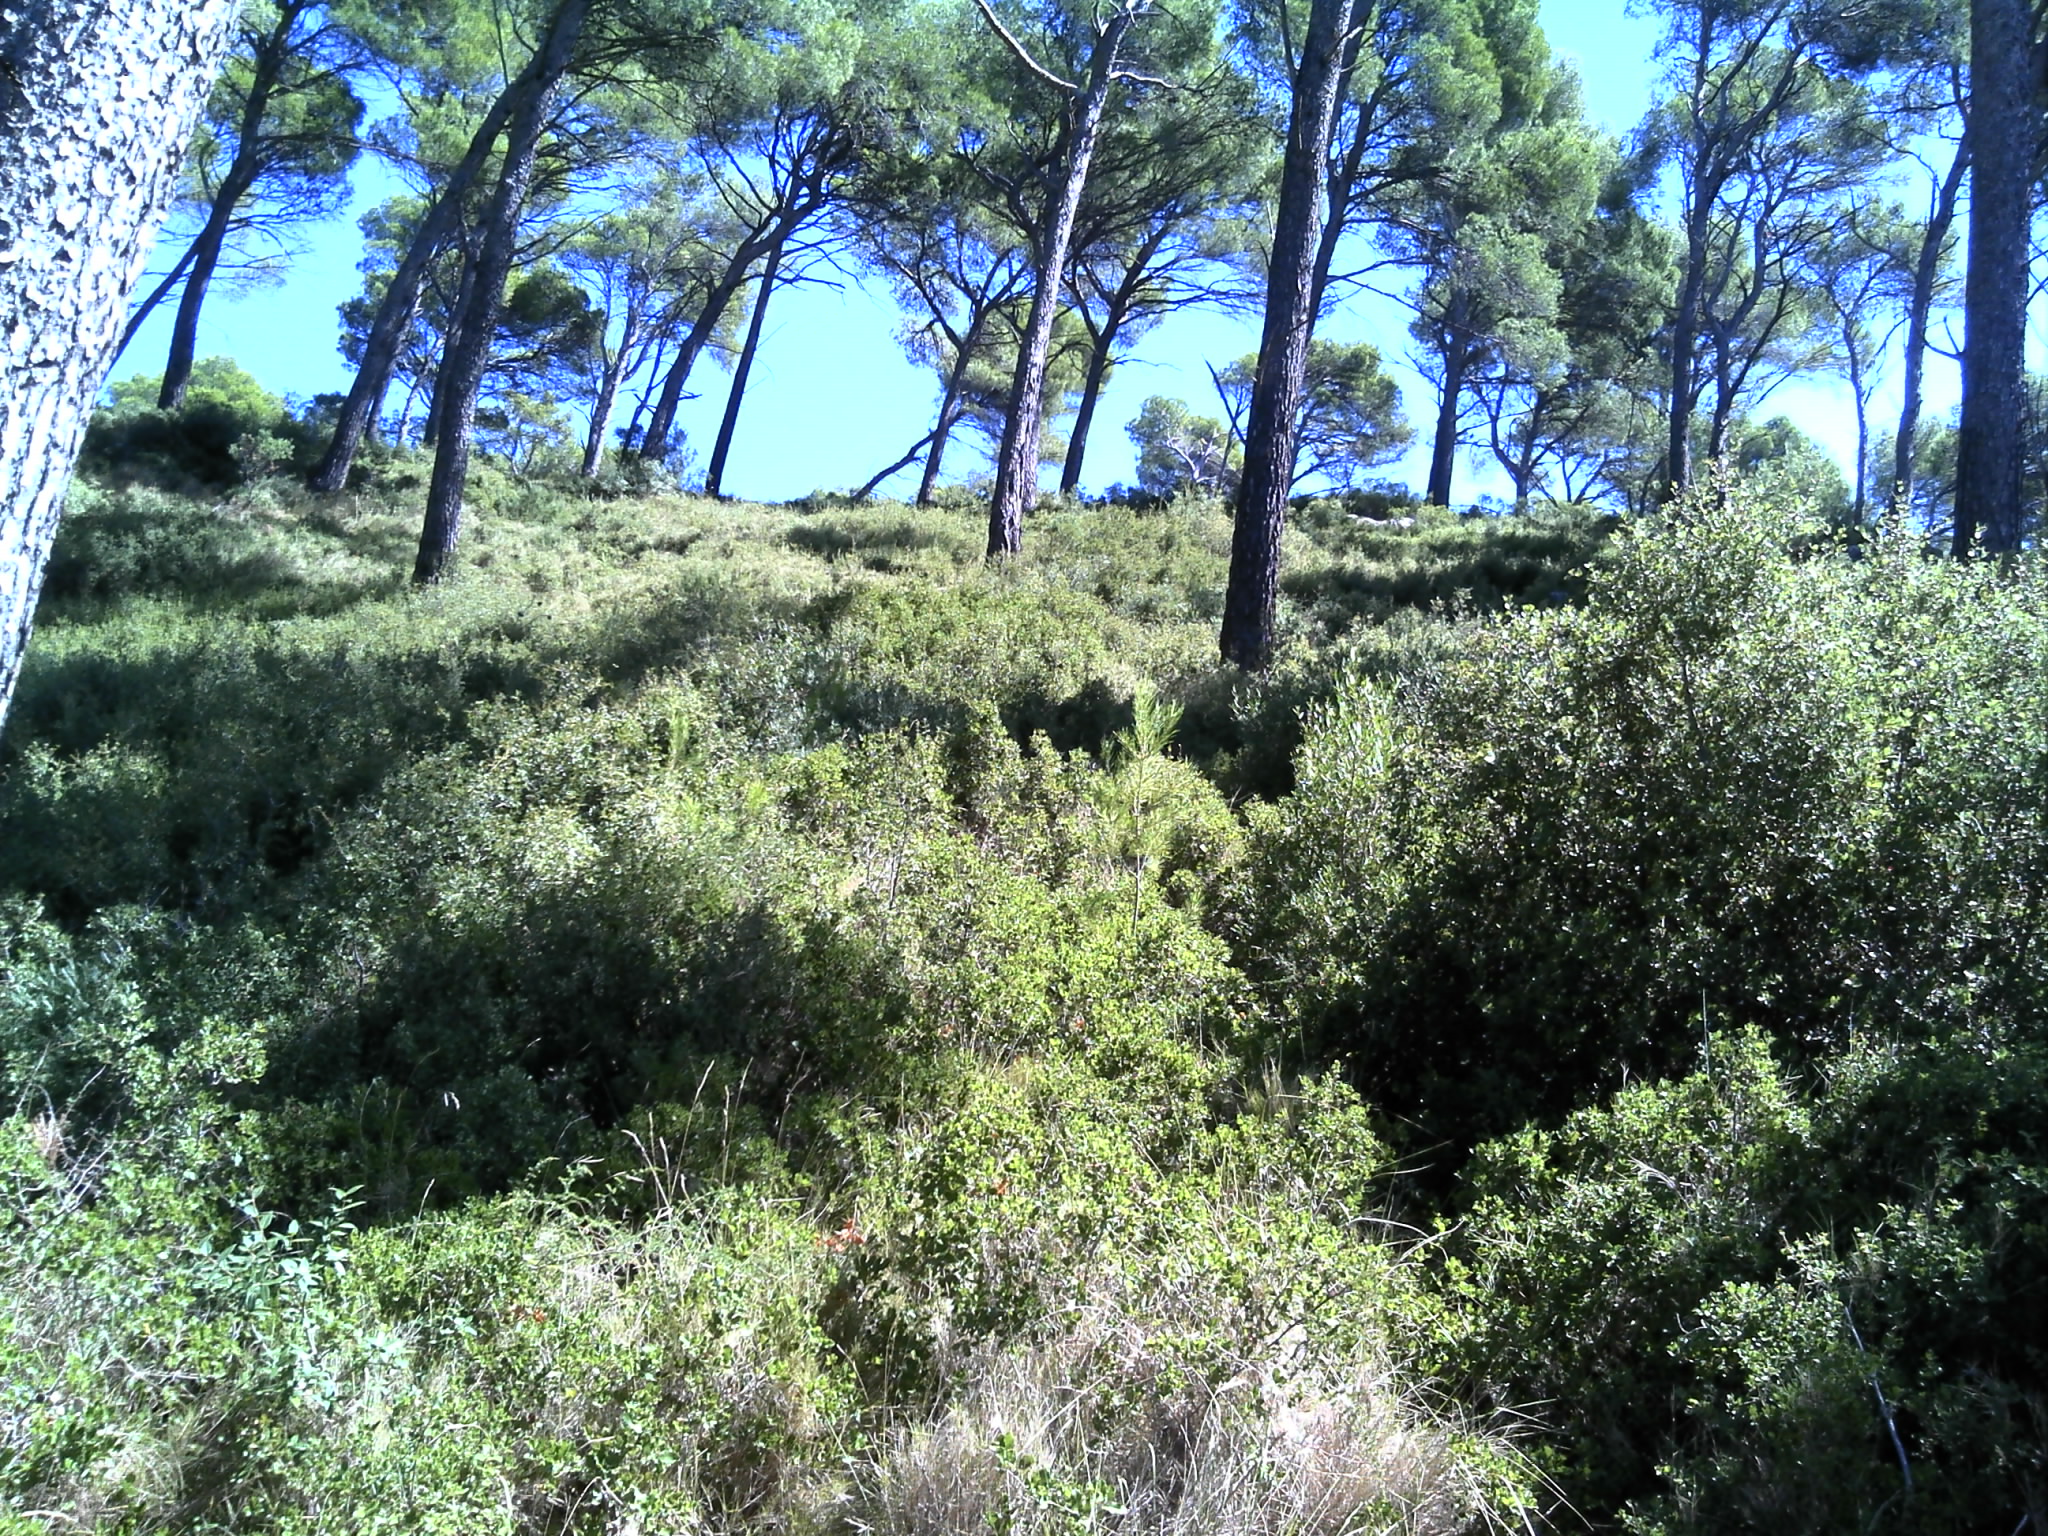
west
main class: Woodland
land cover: Pine dominated coniferous woodland
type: coniferous forest of the mediterranean region
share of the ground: 50 - 75 %
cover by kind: coniferous forest trees 50 %, shrubs 30 %, herbaceous plants 20 %
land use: Forestry
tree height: > 5 m
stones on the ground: < 10 %
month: September
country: FR
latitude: 43.7663
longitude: 5.1272
